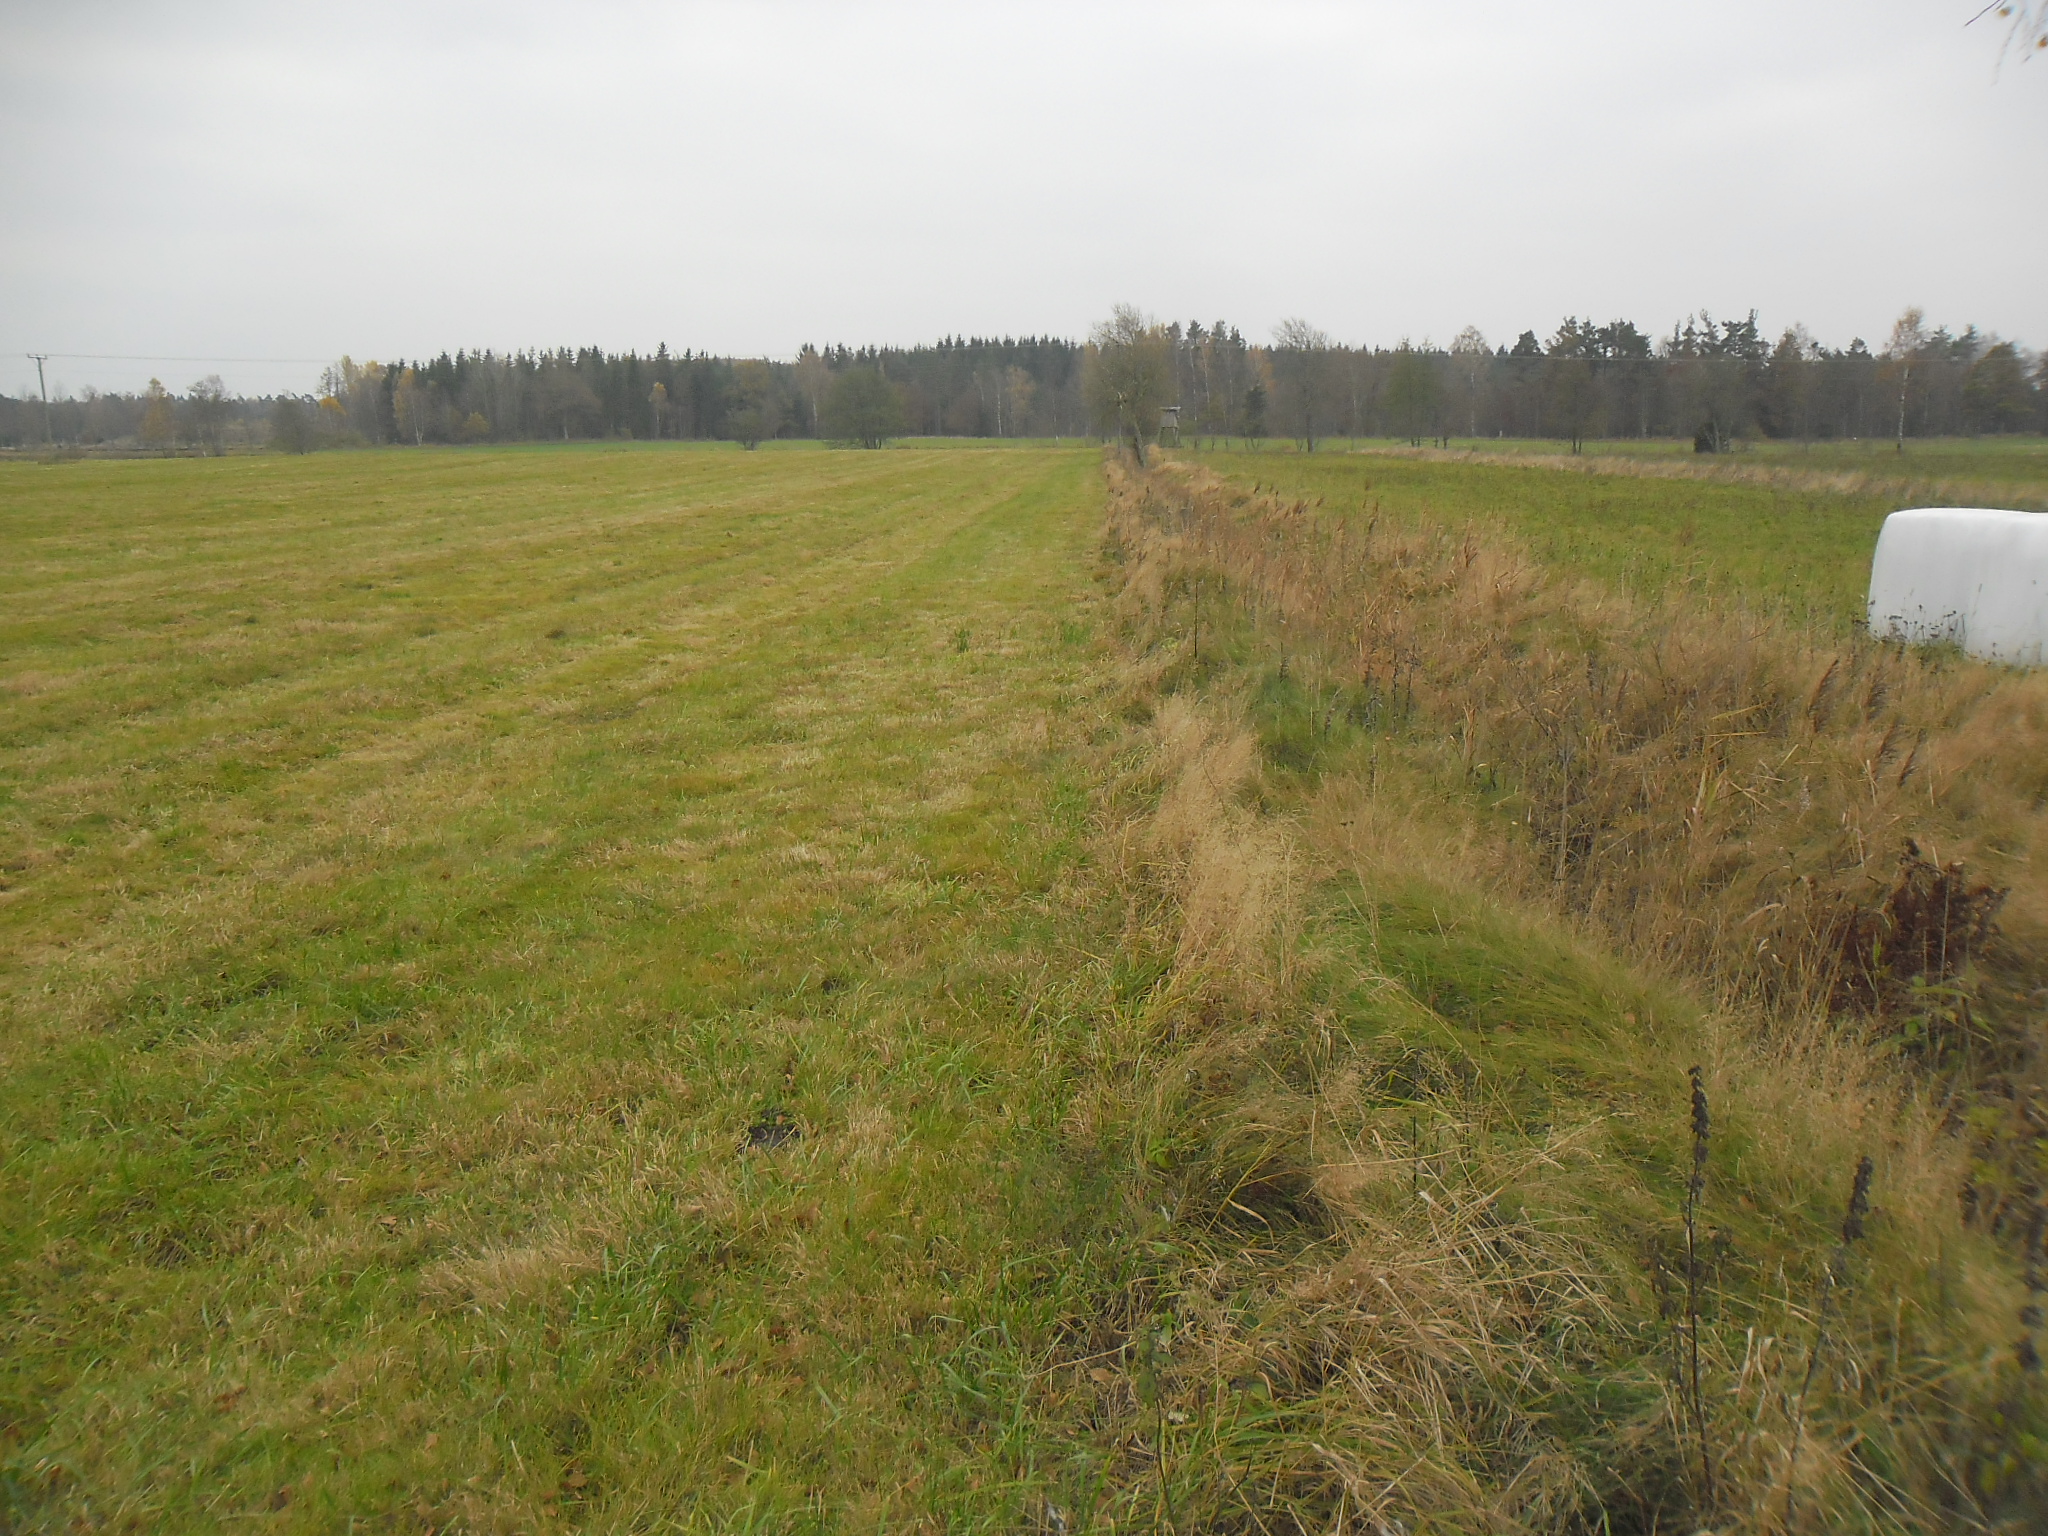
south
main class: Grassland
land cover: Grassland without tree/shrub cover
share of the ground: > 75 %
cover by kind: herbaceous plants 100 %
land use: Agriculture (excluding fallow land and kitchen gardens)
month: October
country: SE
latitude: 56.4719
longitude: 13.1950
